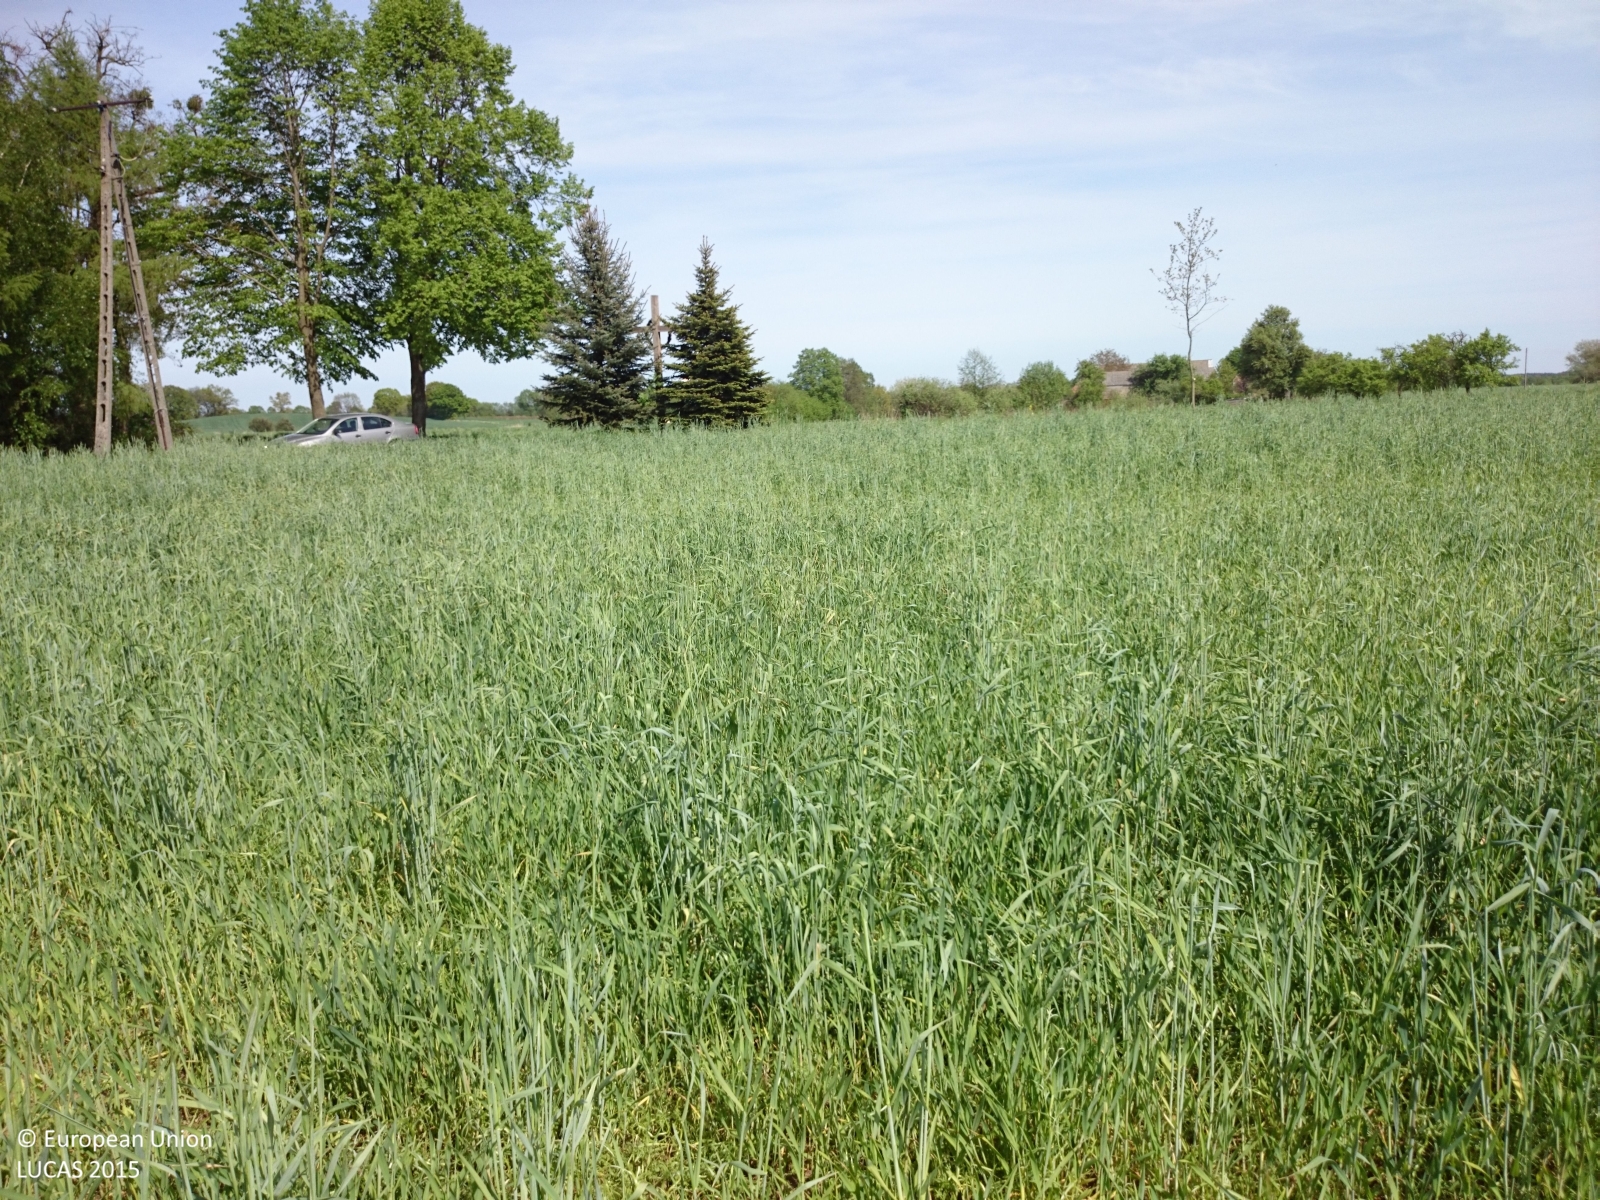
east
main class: Cropland
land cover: Rye
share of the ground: > 75 %
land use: Agriculture (excluding fallow land and kitchen gardens)
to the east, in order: Rye; Grass margins; Lines of trees; Grass margins; Paved roads, cycling and walking lanes; Grass margins; Triticale; Shrubland with sparse tree cover; Inland fresh water bodies; Shrubland with sparse tree cover; Triticale; Grass margins; Artificial constructions in urban areas; Grass margins; Spontaneously vegetated surfaces
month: May
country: PL
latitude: 52.5556
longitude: 16.2454
